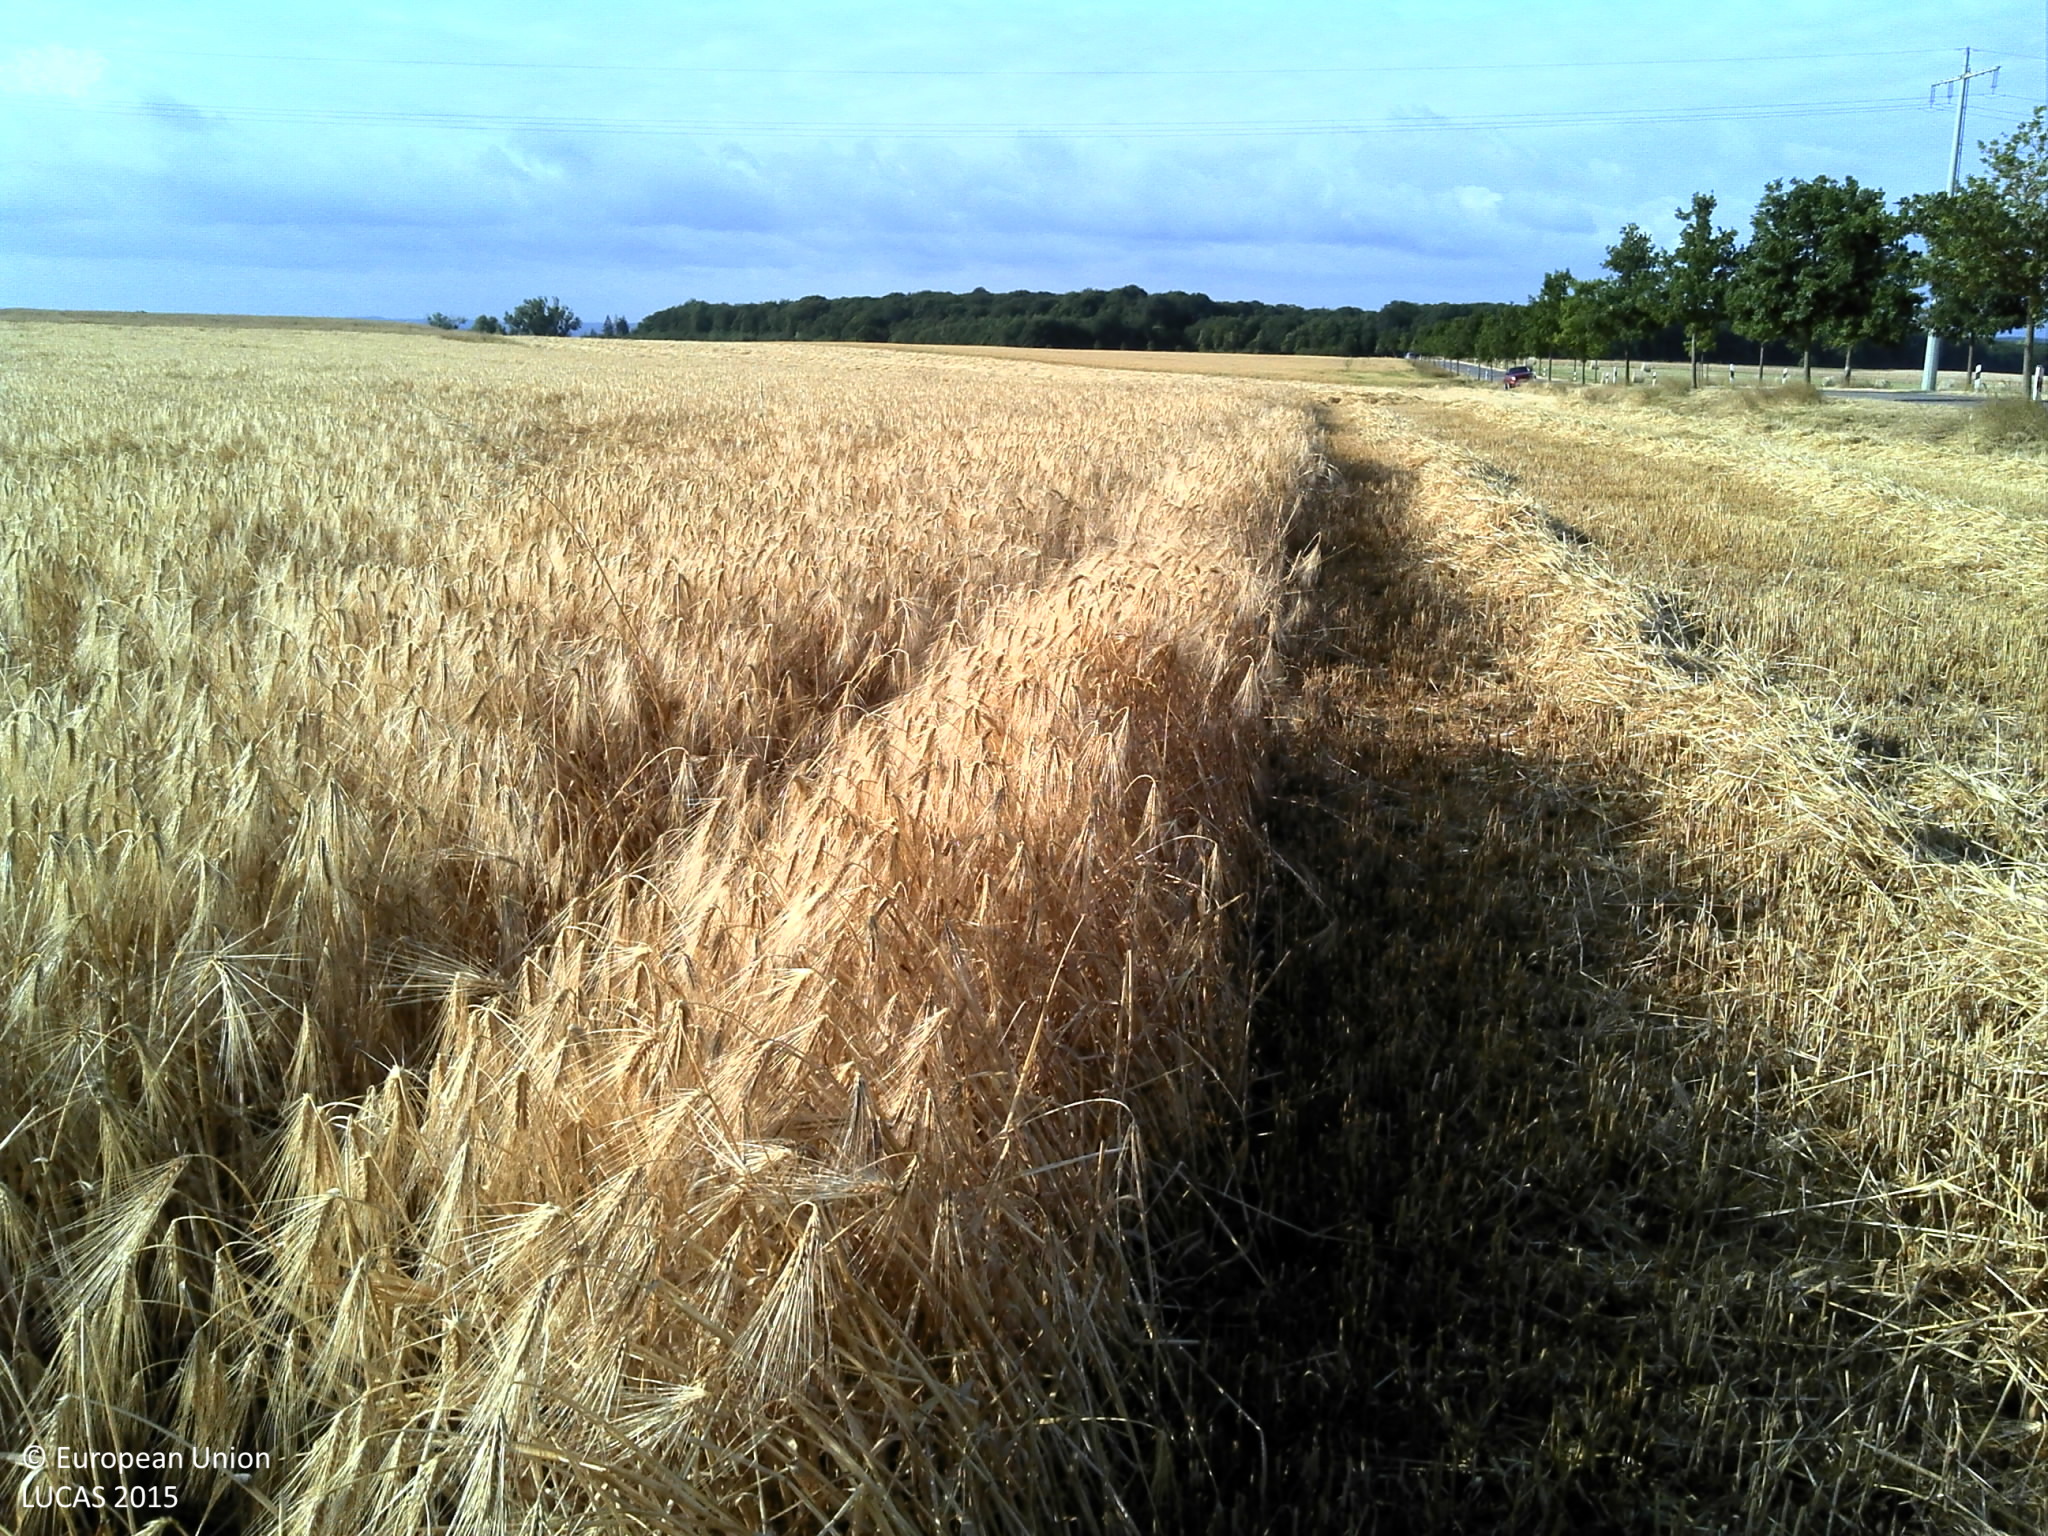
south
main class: Cropland
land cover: Barley
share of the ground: > 75 %
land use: Agriculture (excluding fallow land and kitchen gardens)
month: July
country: LU
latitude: 49.5296
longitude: 6.2830
